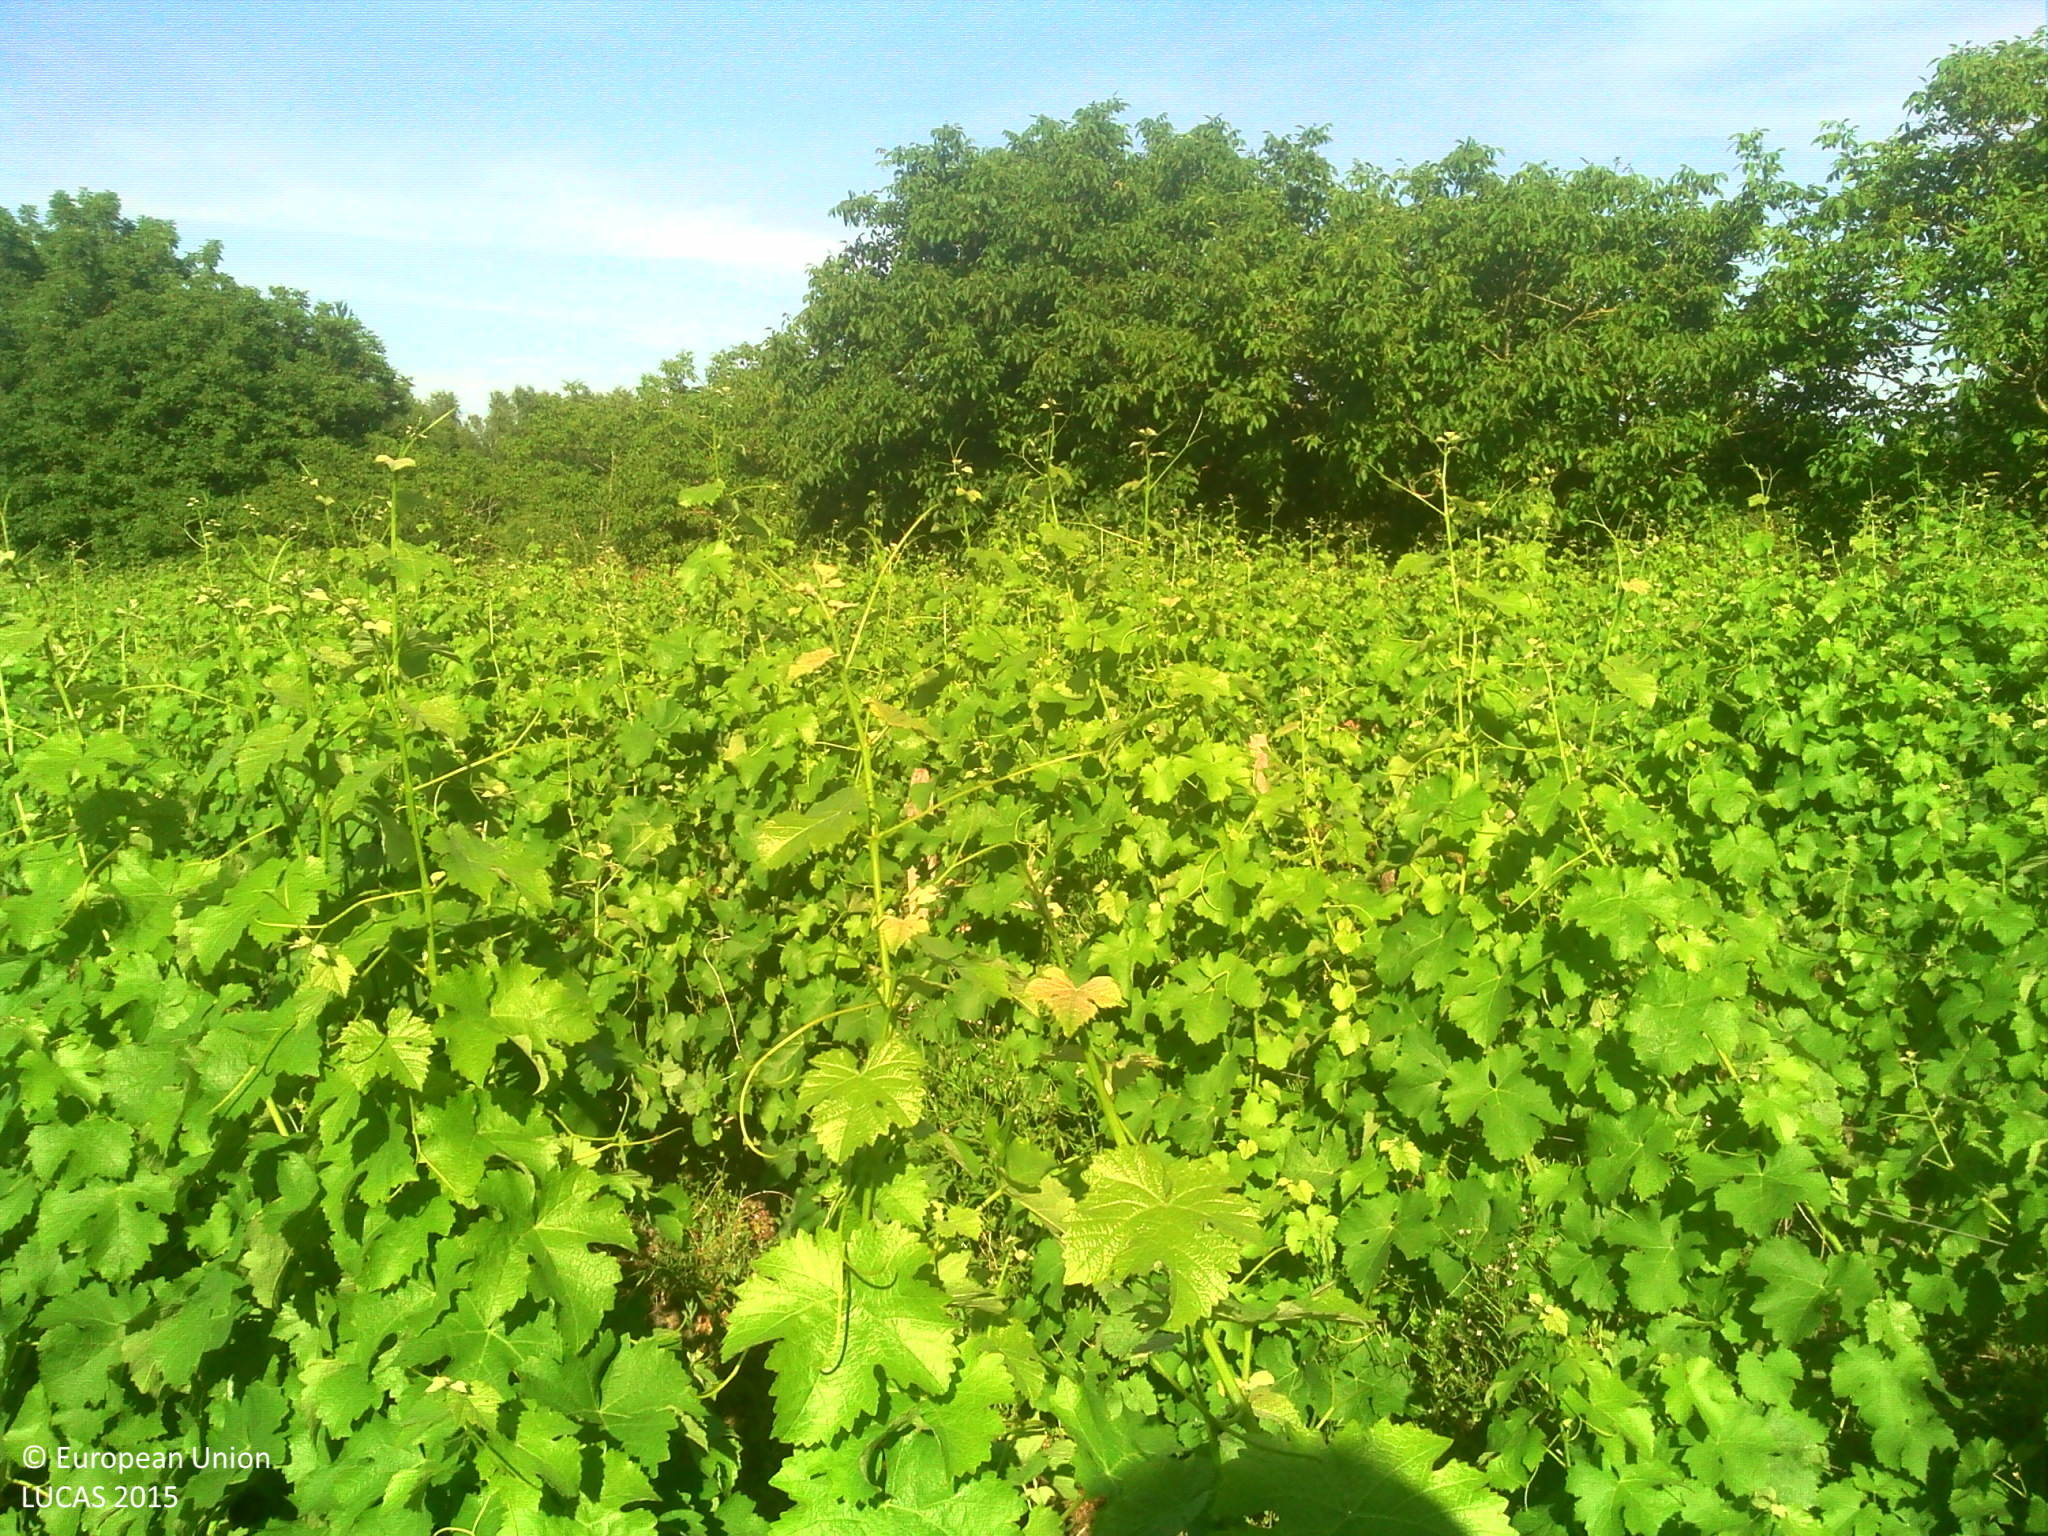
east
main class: Cropland
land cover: Vineyards
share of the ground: 25 - 50 %
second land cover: Other bare soil
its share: > 75 %
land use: Agriculture (excluding fallow land and kitchen gardens)
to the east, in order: Vineyards; Other bare soil; Lines of trees; Other bare soil; Grass margins; Tracks; Grassland with sparse tree/shrub cover; Grassland without tree/shrub cover; Spontaneously vegetated surfaces; Broadleaved woodland
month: June
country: FR
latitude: 47.2764
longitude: 1.4602
